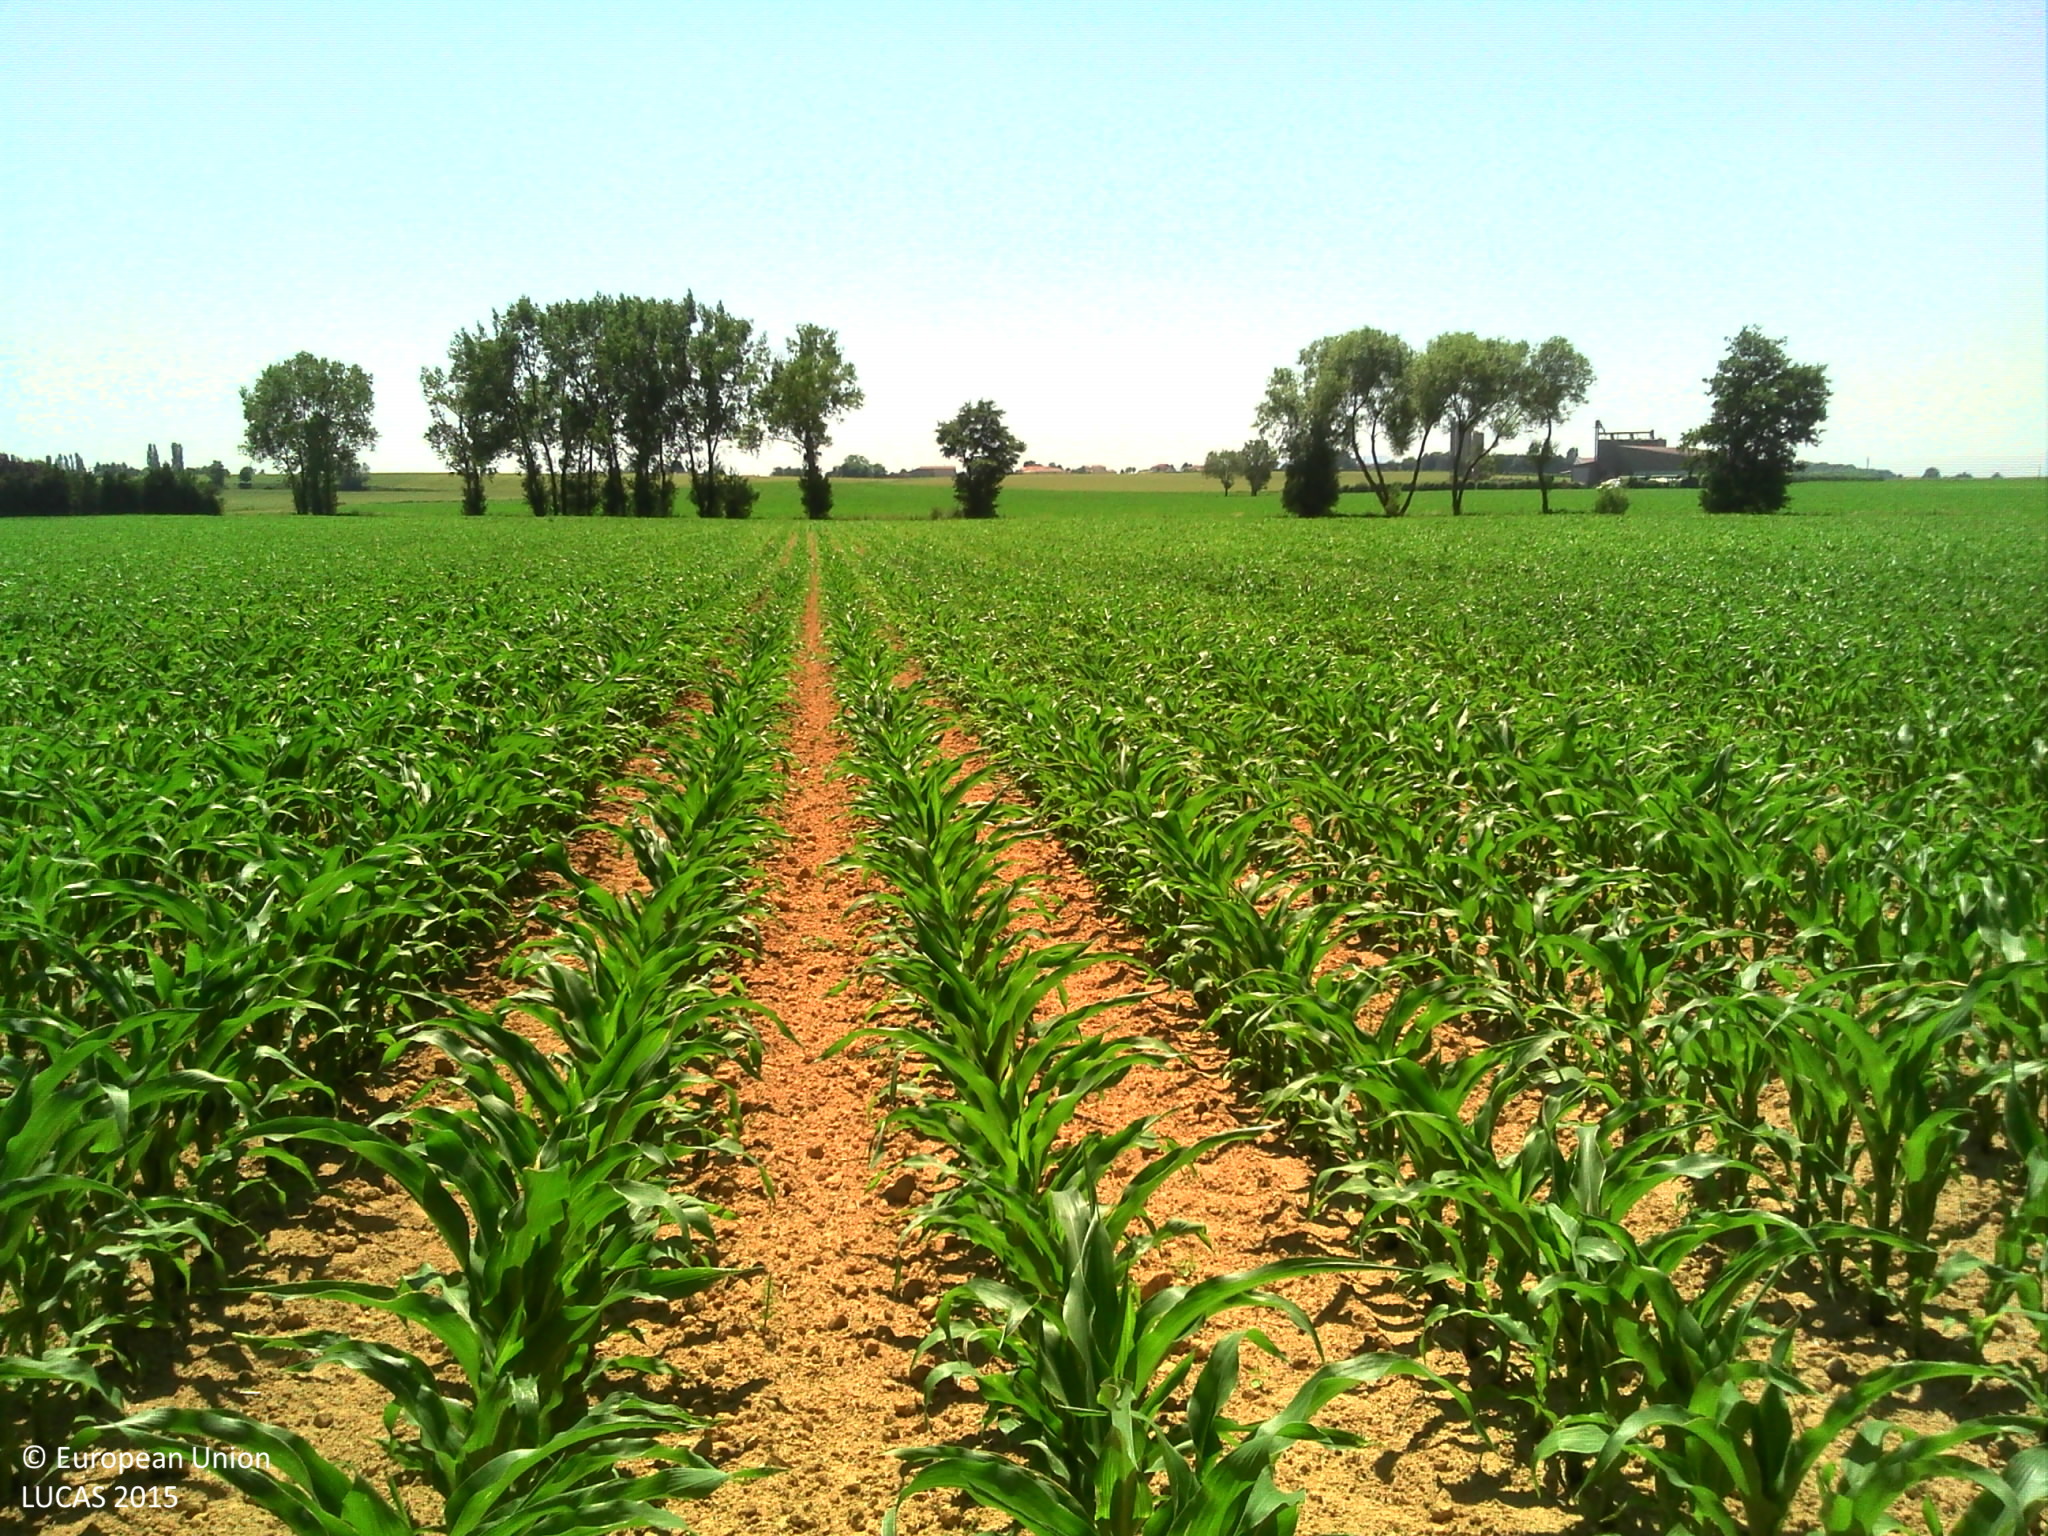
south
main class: Cropland
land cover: Maize
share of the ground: 10 - 25 %
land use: Agriculture (excluding fallow land and kitchen gardens)
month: June
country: FR
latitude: 46.0093
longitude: 4.8242
